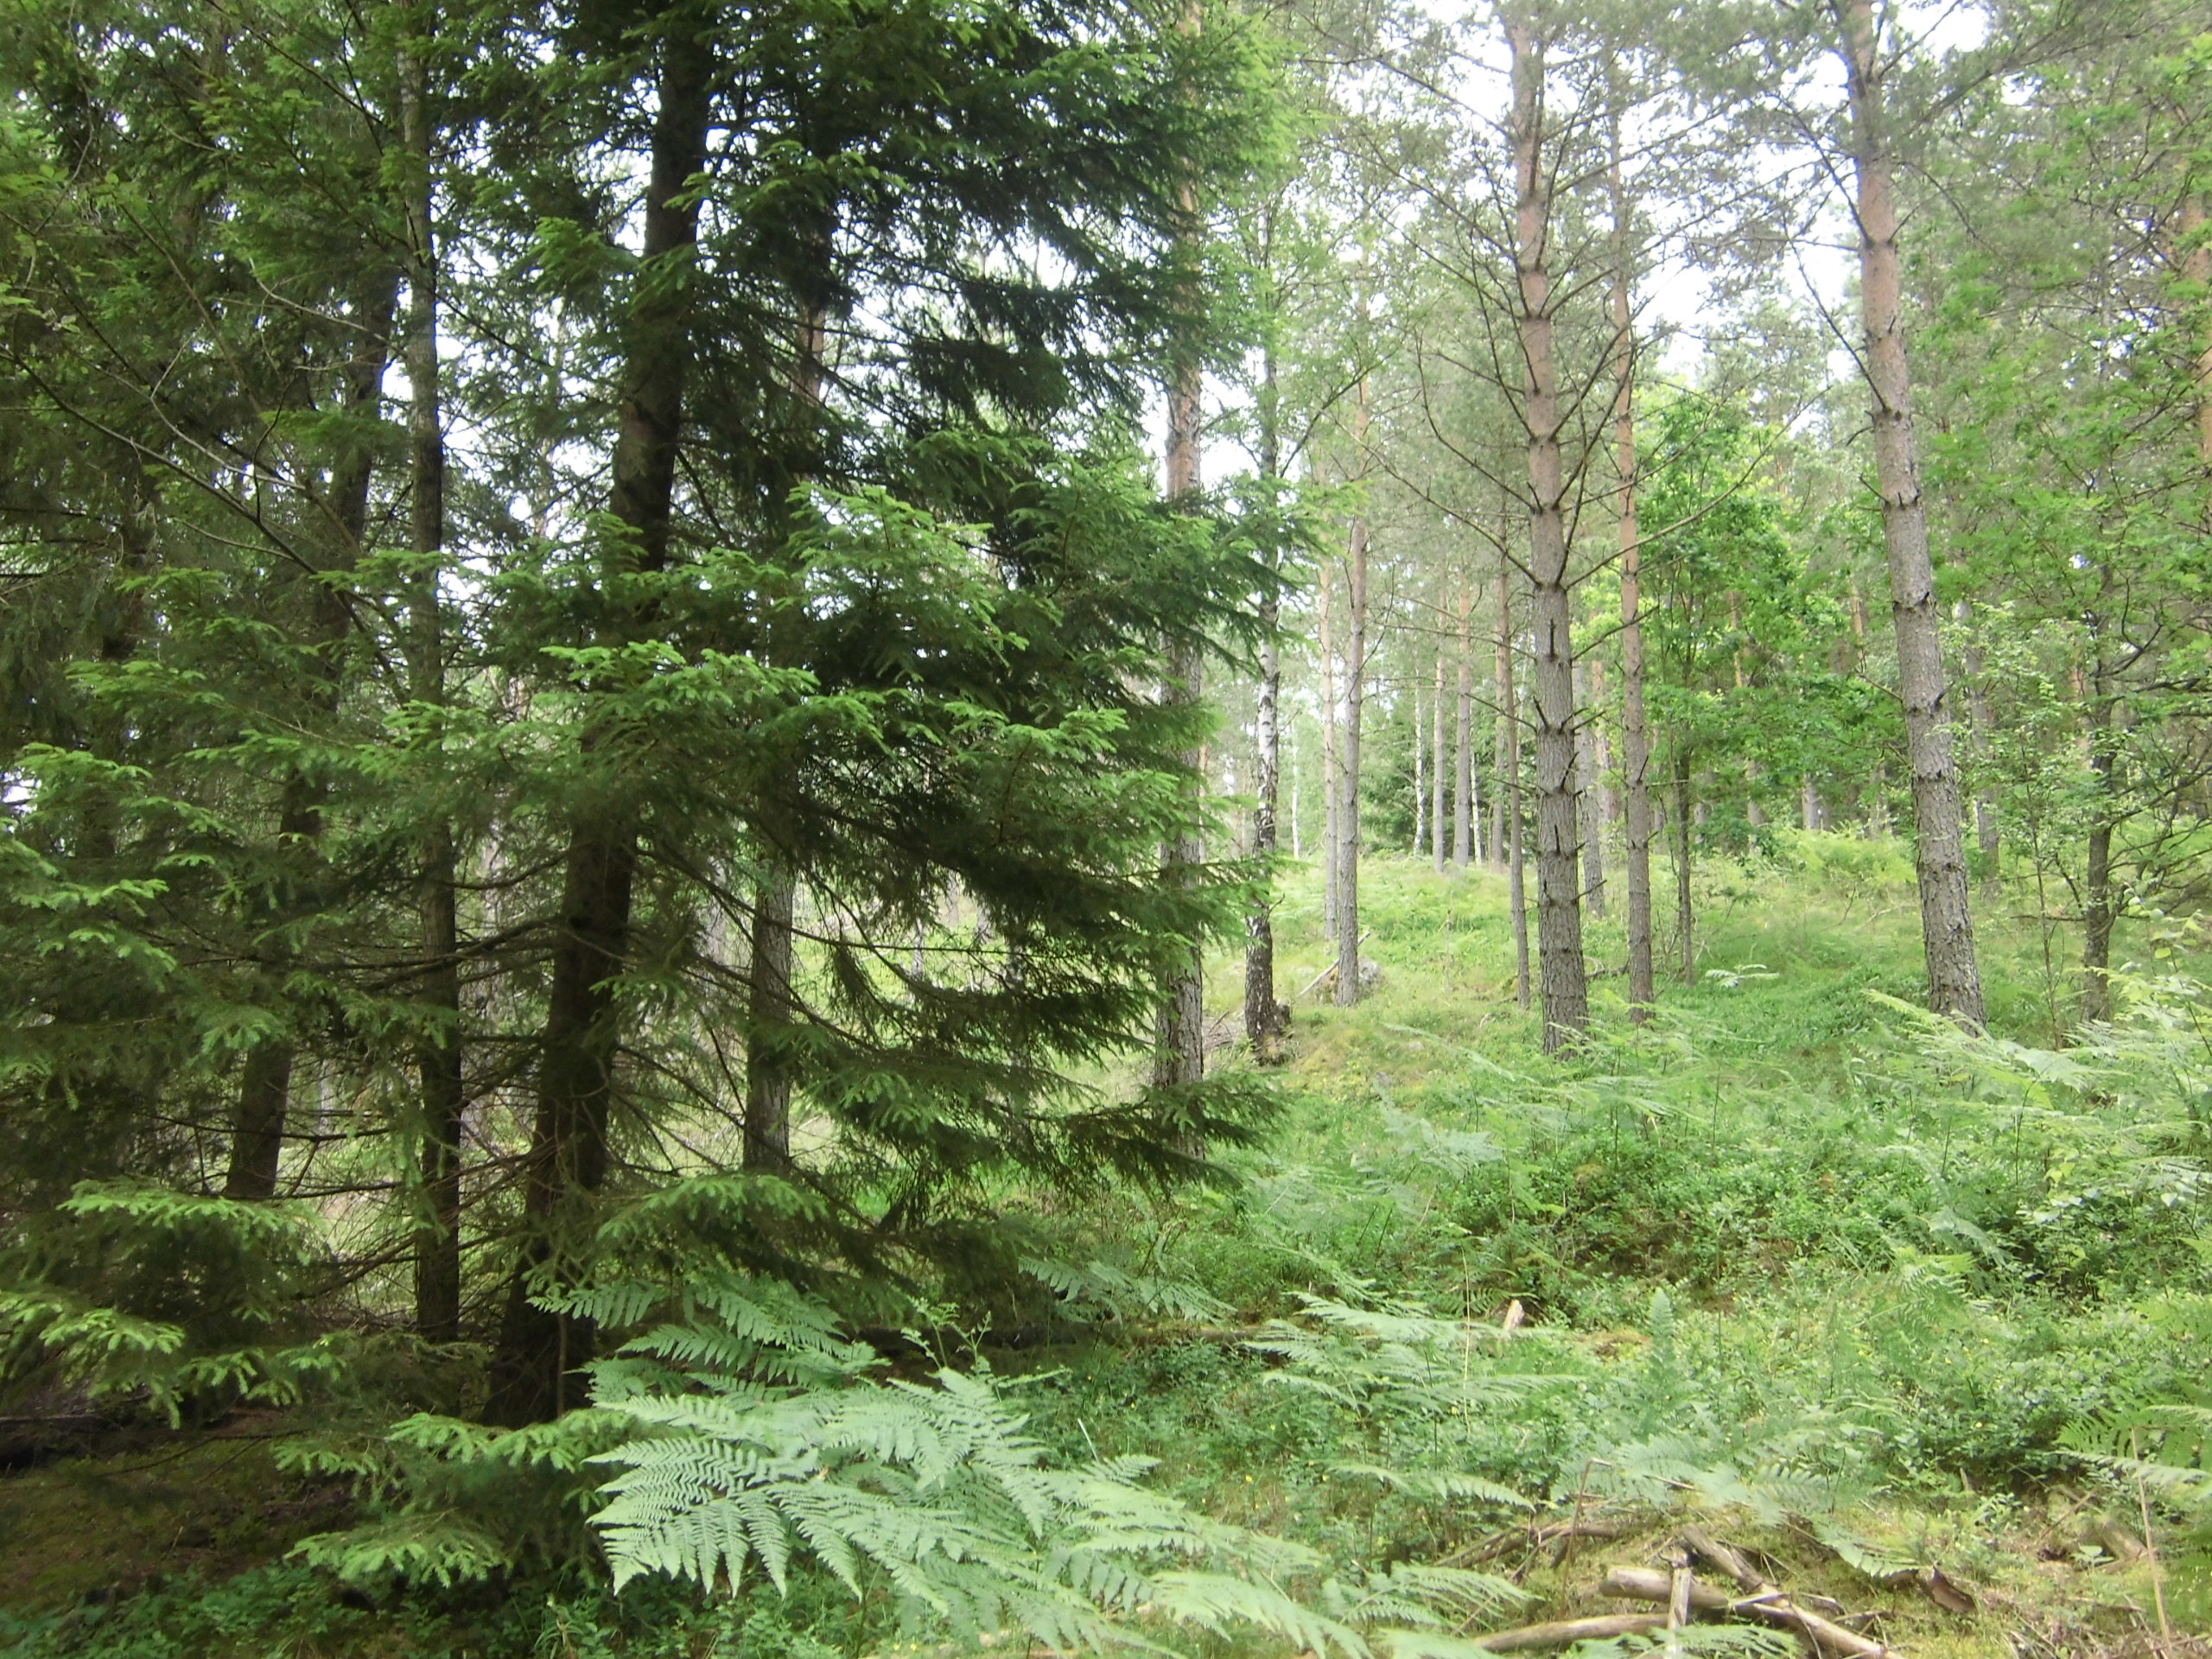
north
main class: Woodland
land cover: Pine dominated coniferous woodland
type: boreal forest
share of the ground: 50 - 75 %
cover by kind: coniferous forest trees 55 %, herbaceous plants 30 %, broadleaved forest trees 5 %, shrubs 5 %, lichens and mosses 5 %
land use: Forestry
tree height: > 5 m
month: July
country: SE
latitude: 57.3721
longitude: 14.9351
